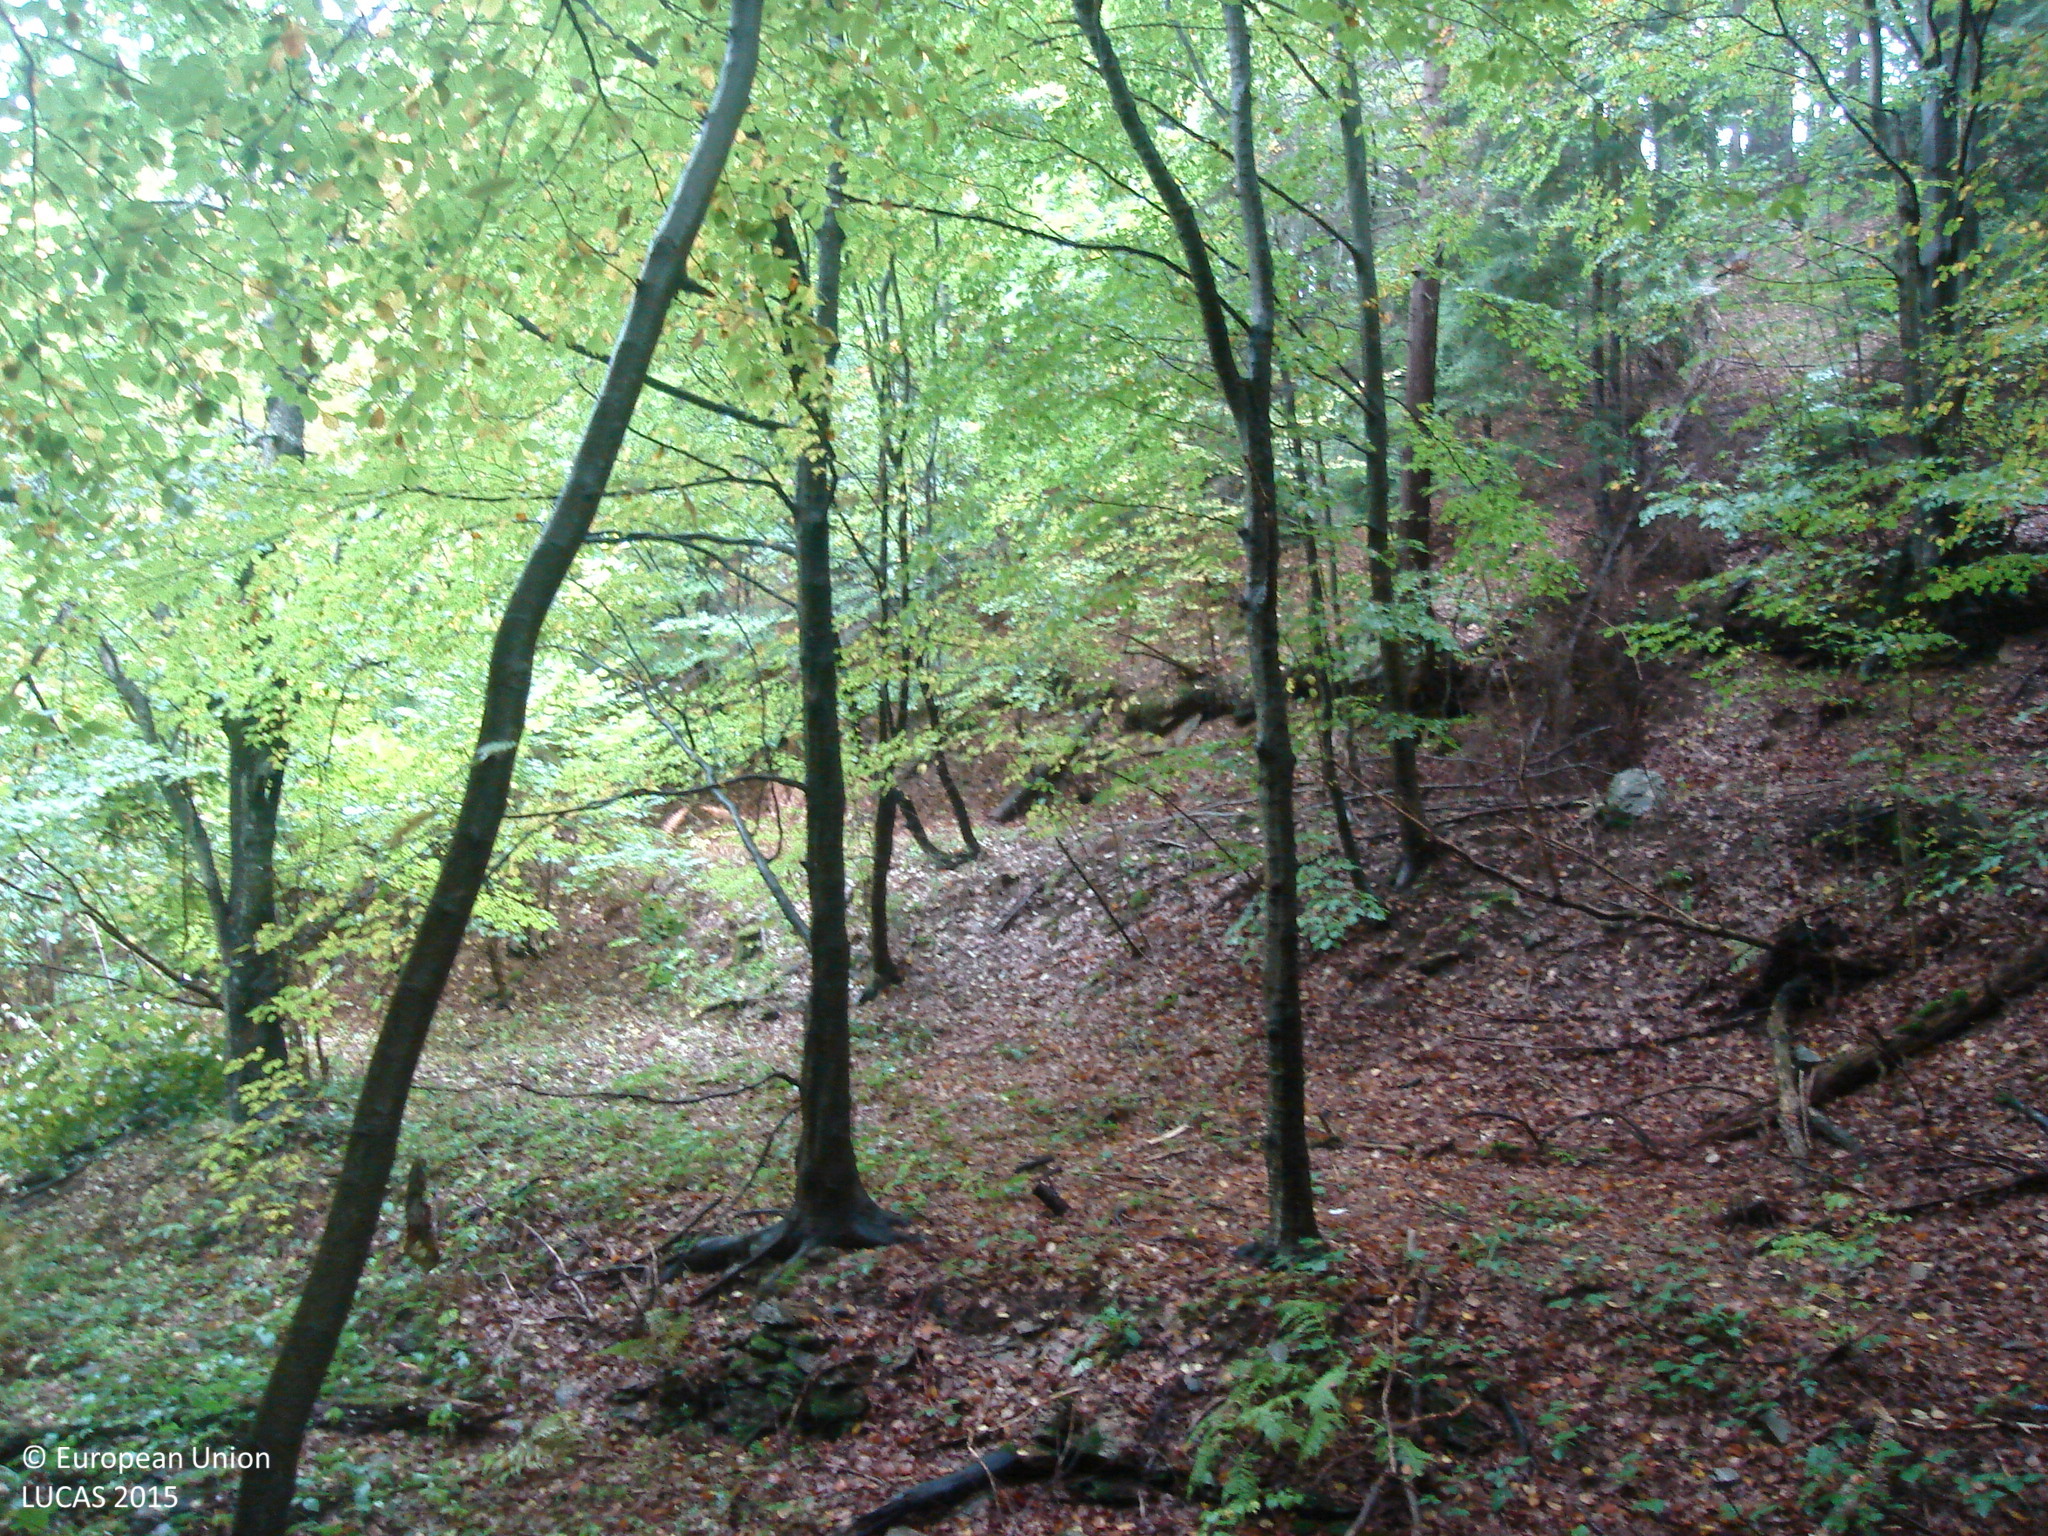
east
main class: Woodland
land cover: Broadleaved woodland
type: beech forest
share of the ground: > 75 %
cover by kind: broadleaved forest trees 95 %, unconsolidated bare surface 5 %
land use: Forestry
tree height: > 5 m
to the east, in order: Broadleaved woodland; Rivers and streams; Broadleaved woodland; Tracks; Broadleaved woodland; Pine dominated coniferous woodland; Ditches and canals; Paved roads, cycling and walking lanes; Broadleaved woodland; Electric lines; Inland fresh running water; Broadleaved woodland; Pine dominated coniferous woodland; Broadleaved woodland
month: October
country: BG
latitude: 42.6715
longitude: 24.3386
